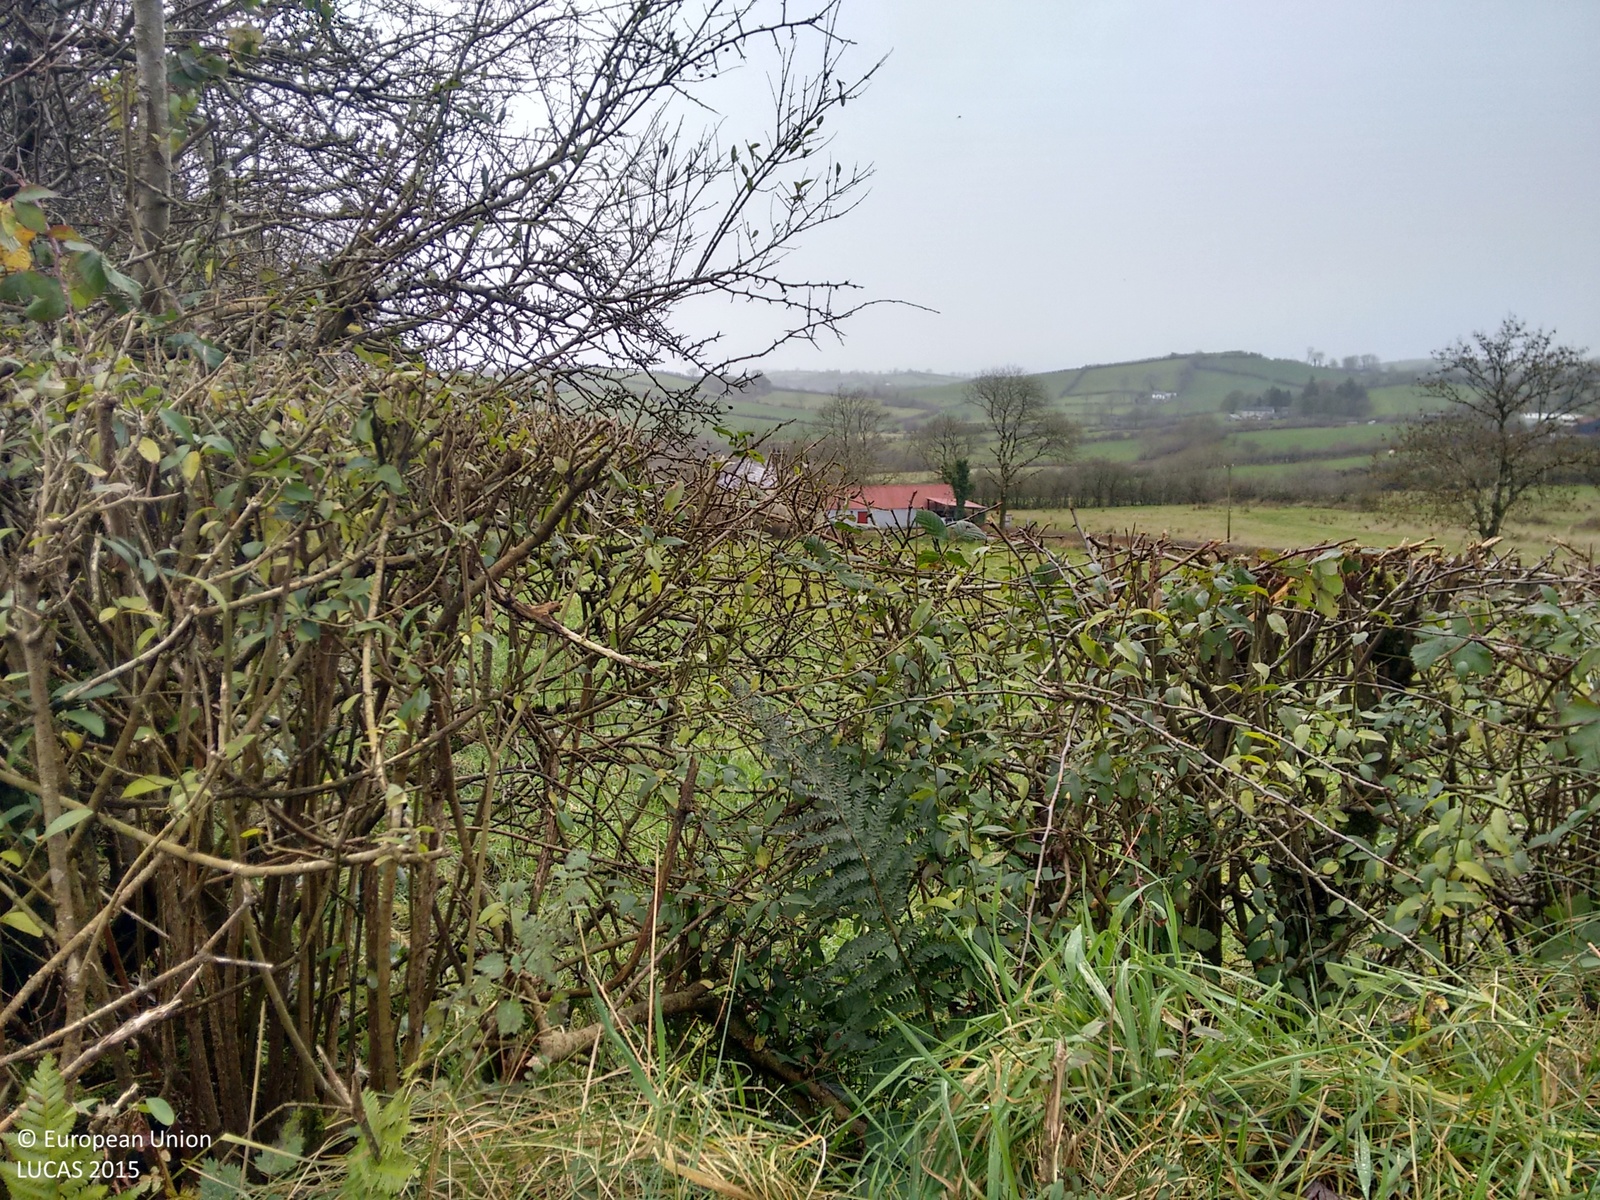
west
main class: Grassland
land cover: Grassland without tree/shrub cover
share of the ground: > 75 %
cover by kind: herbaceous plants 100 %
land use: Agriculture (excluding fallow land and kitchen gardens)
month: December
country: IE
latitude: 54.0602
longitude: -6.8972
